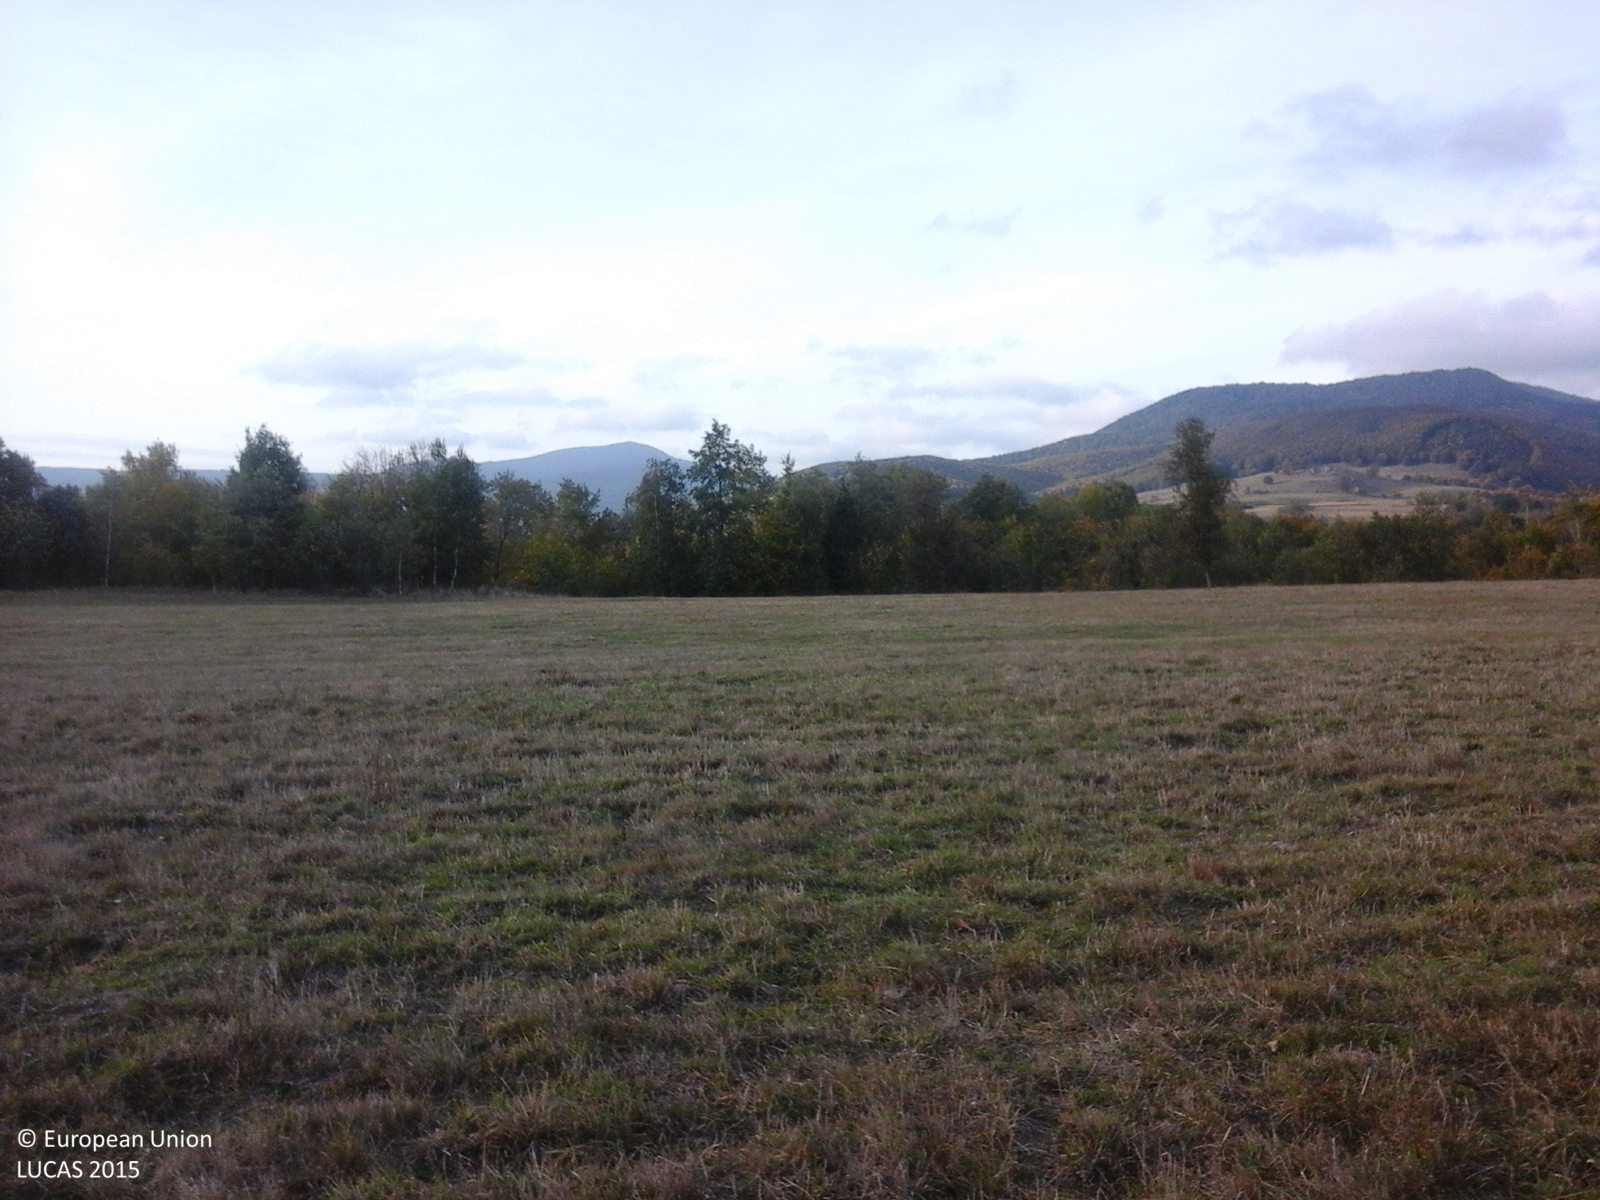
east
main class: Grassland
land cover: Grassland without tree/shrub cover
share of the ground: > 75 %
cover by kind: herbaceous plants 100 %
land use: Agriculture (excluding fallow land and kitchen gardens)
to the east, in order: Grassland without tree/shrub cover; Abandoned hedges; Grassland without tree/shrub cover; Broadleaved woodland; Rivers and streams; Broadleaved woodland
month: October
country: RO
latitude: 46.0906
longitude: 25.8808
